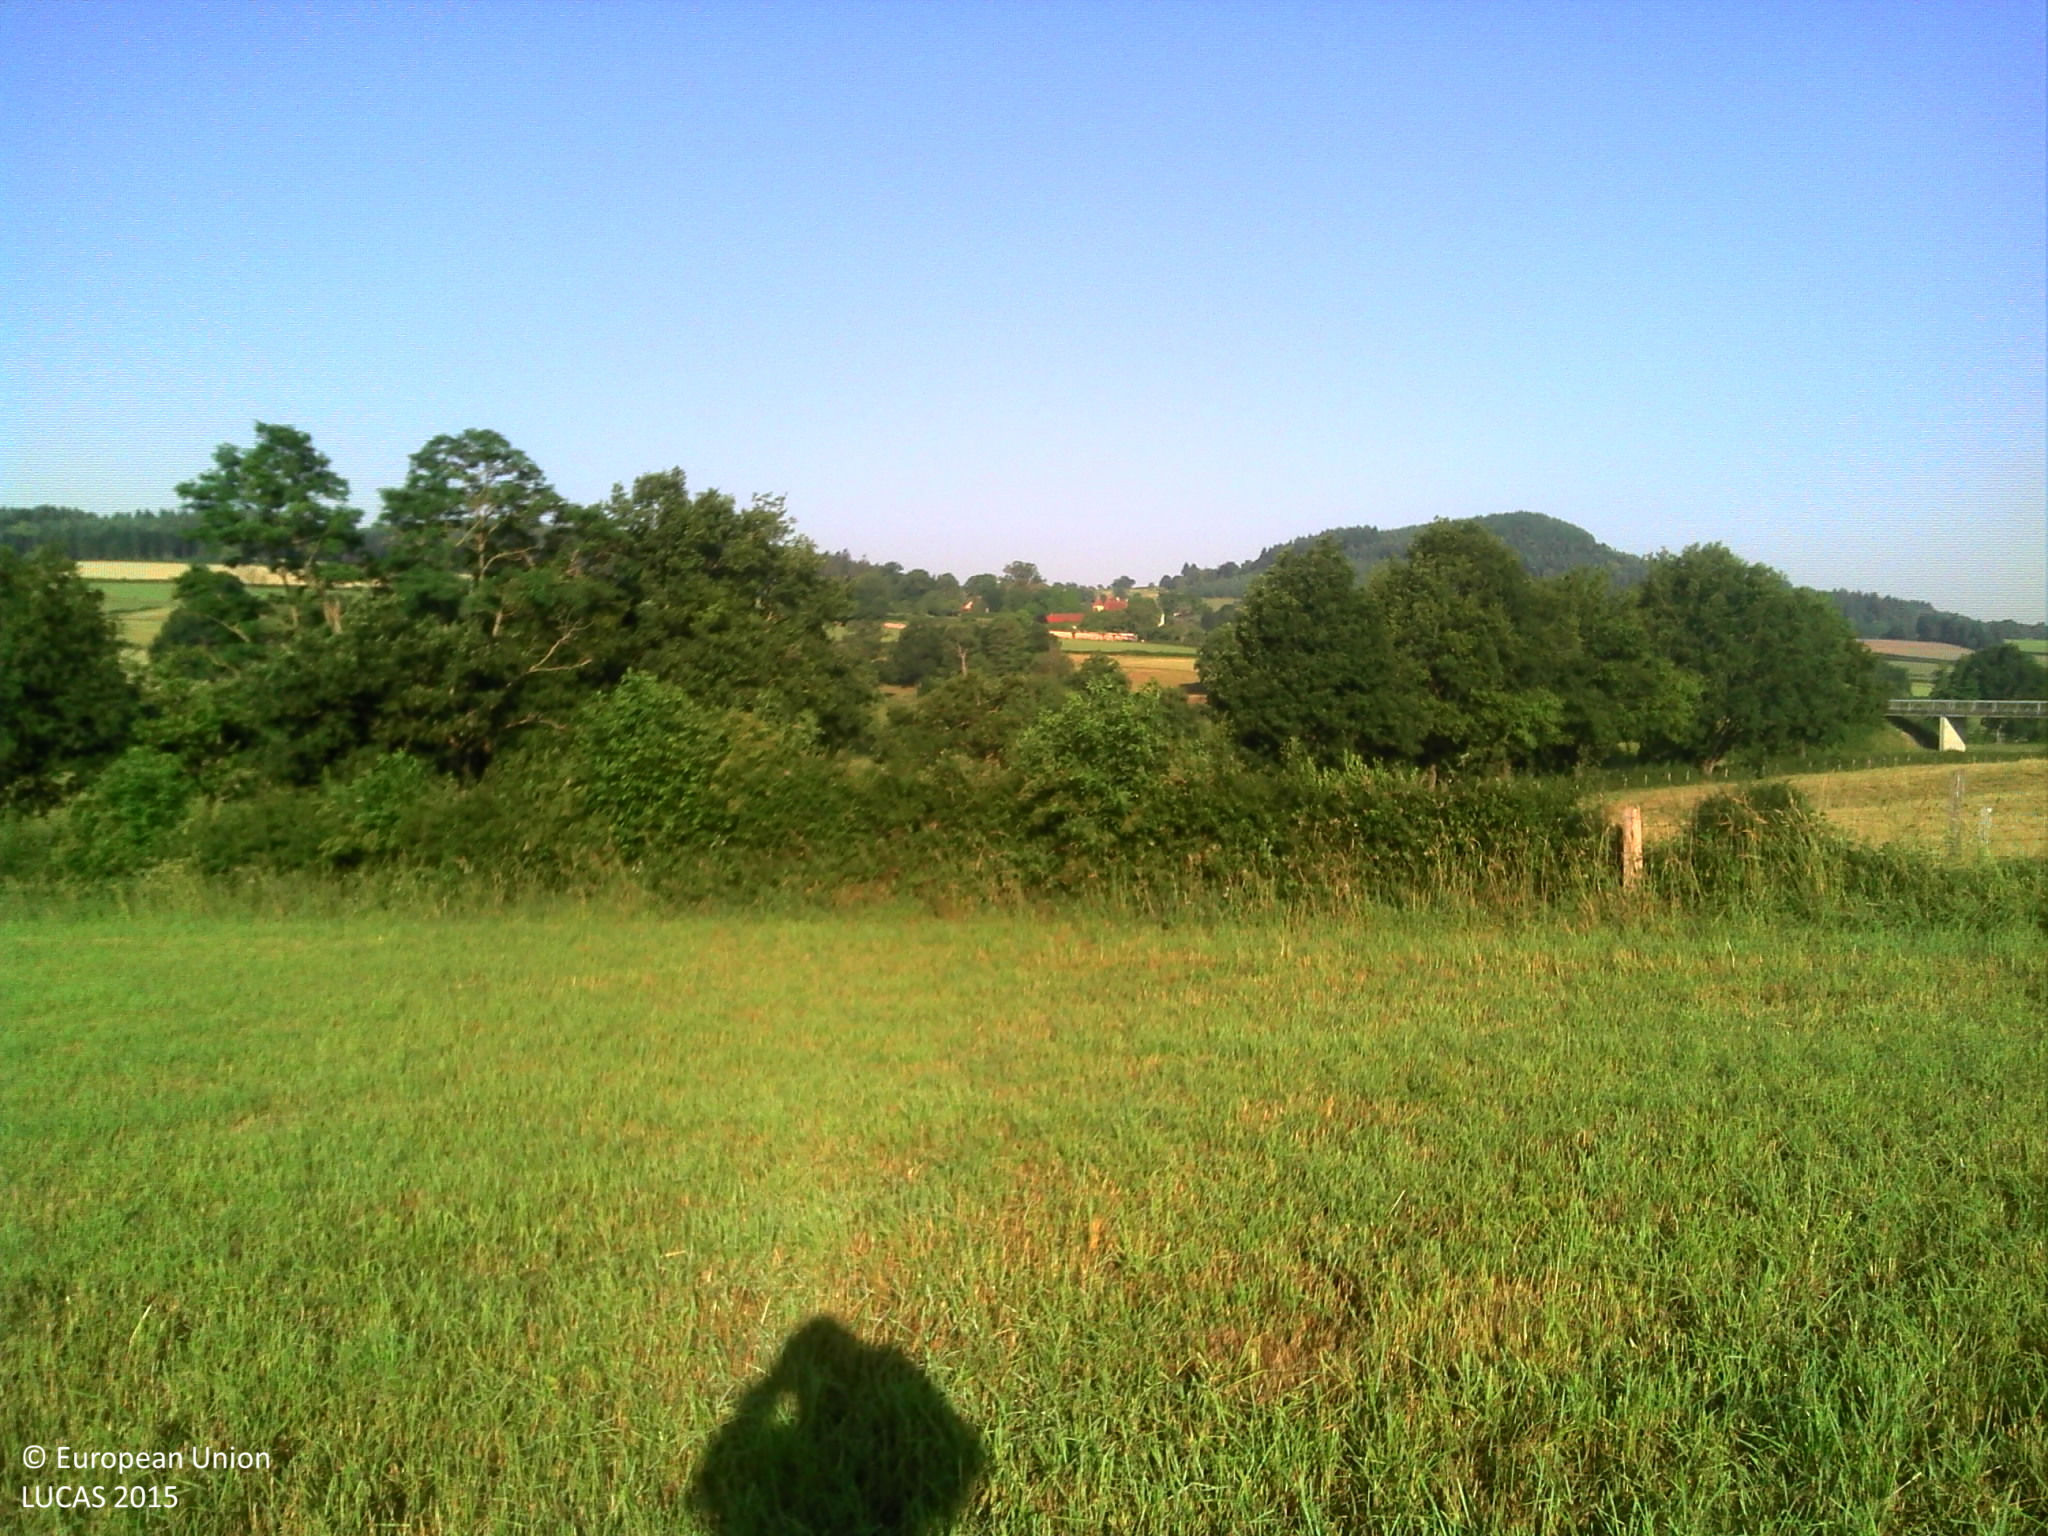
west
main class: Grassland
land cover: Grassland without tree/shrub cover
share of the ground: > 75 %
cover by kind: herbaceous plants 100 %
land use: Agriculture (excluding fallow land and kitchen gardens)
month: June
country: FR
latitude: 46.4222
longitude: 4.4193
